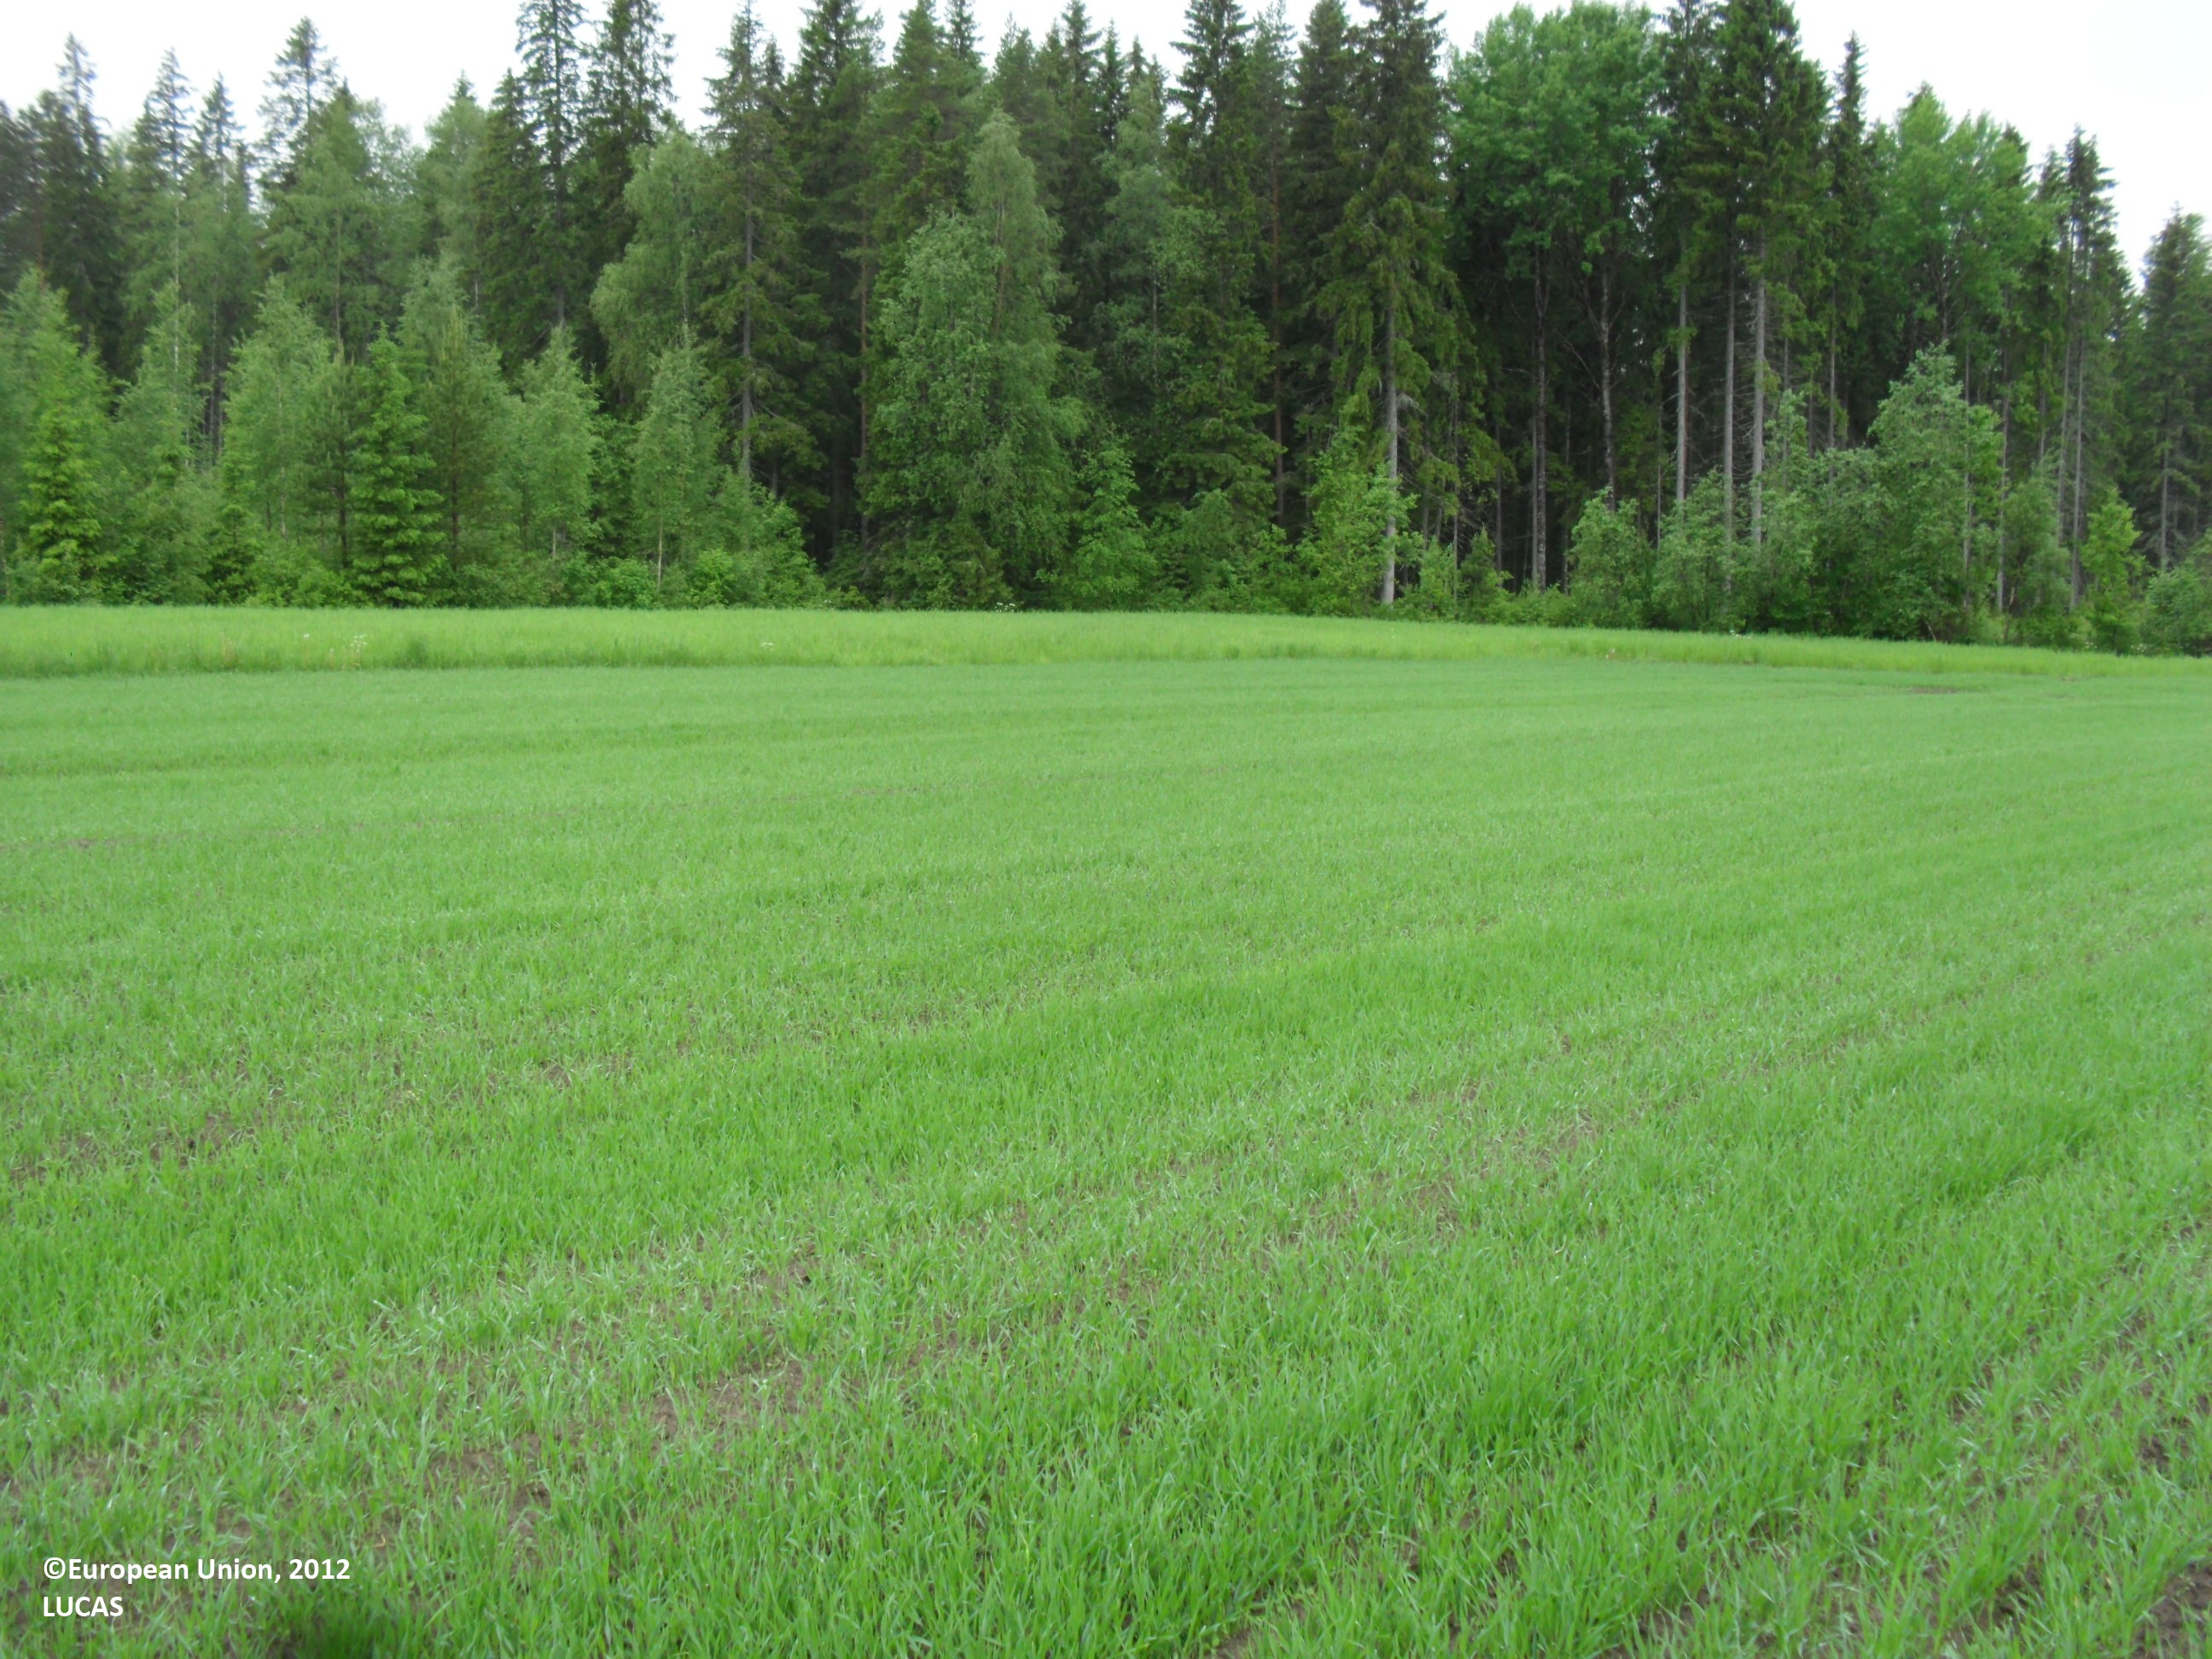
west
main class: Cropland
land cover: Barley
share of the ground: 50 - 75 %
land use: Agriculture (excluding fallow land and kitchen gardens)
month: June
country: FI
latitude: 63.0745
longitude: 23.1843
